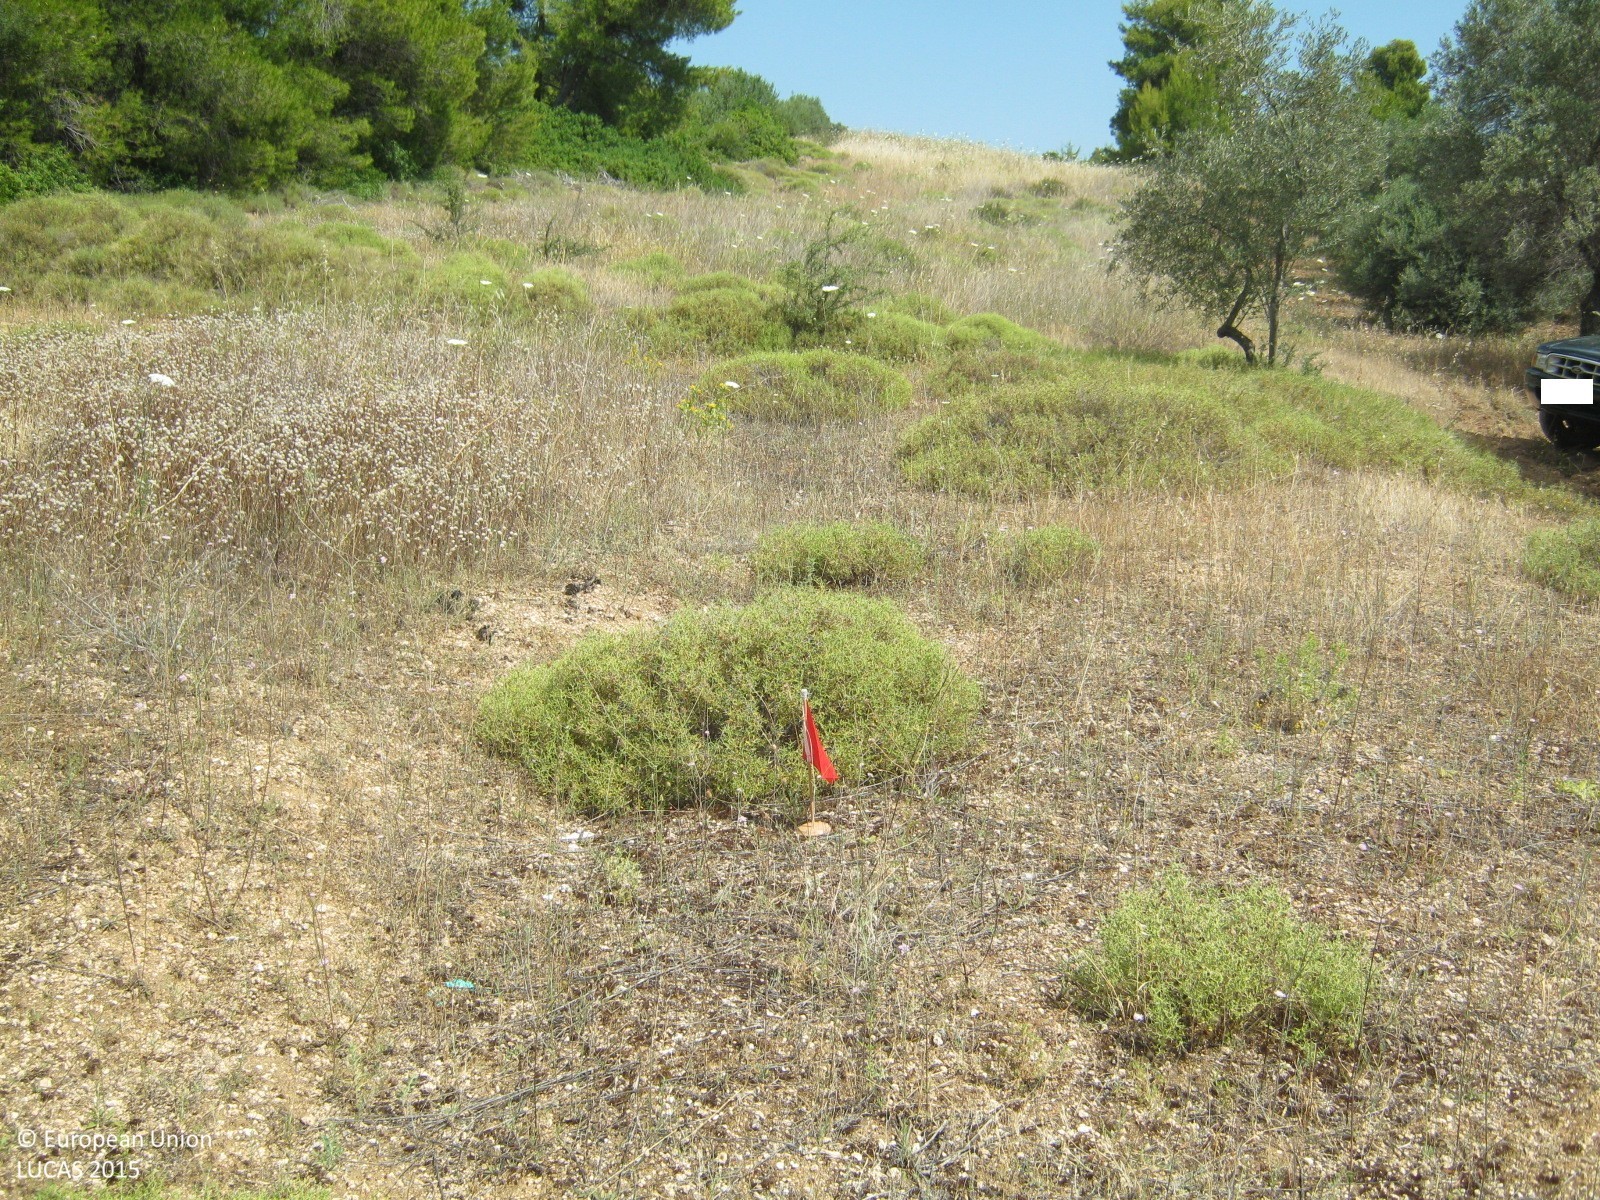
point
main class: Grassland
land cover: Spontaneously vegetated surfaces
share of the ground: > 75 %
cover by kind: herbaceous plants 95 %, shrubs 5 %
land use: Agriculture (excluding fallow land and kitchen gardens)
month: June
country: GR
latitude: 38.5609
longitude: 23.7490
